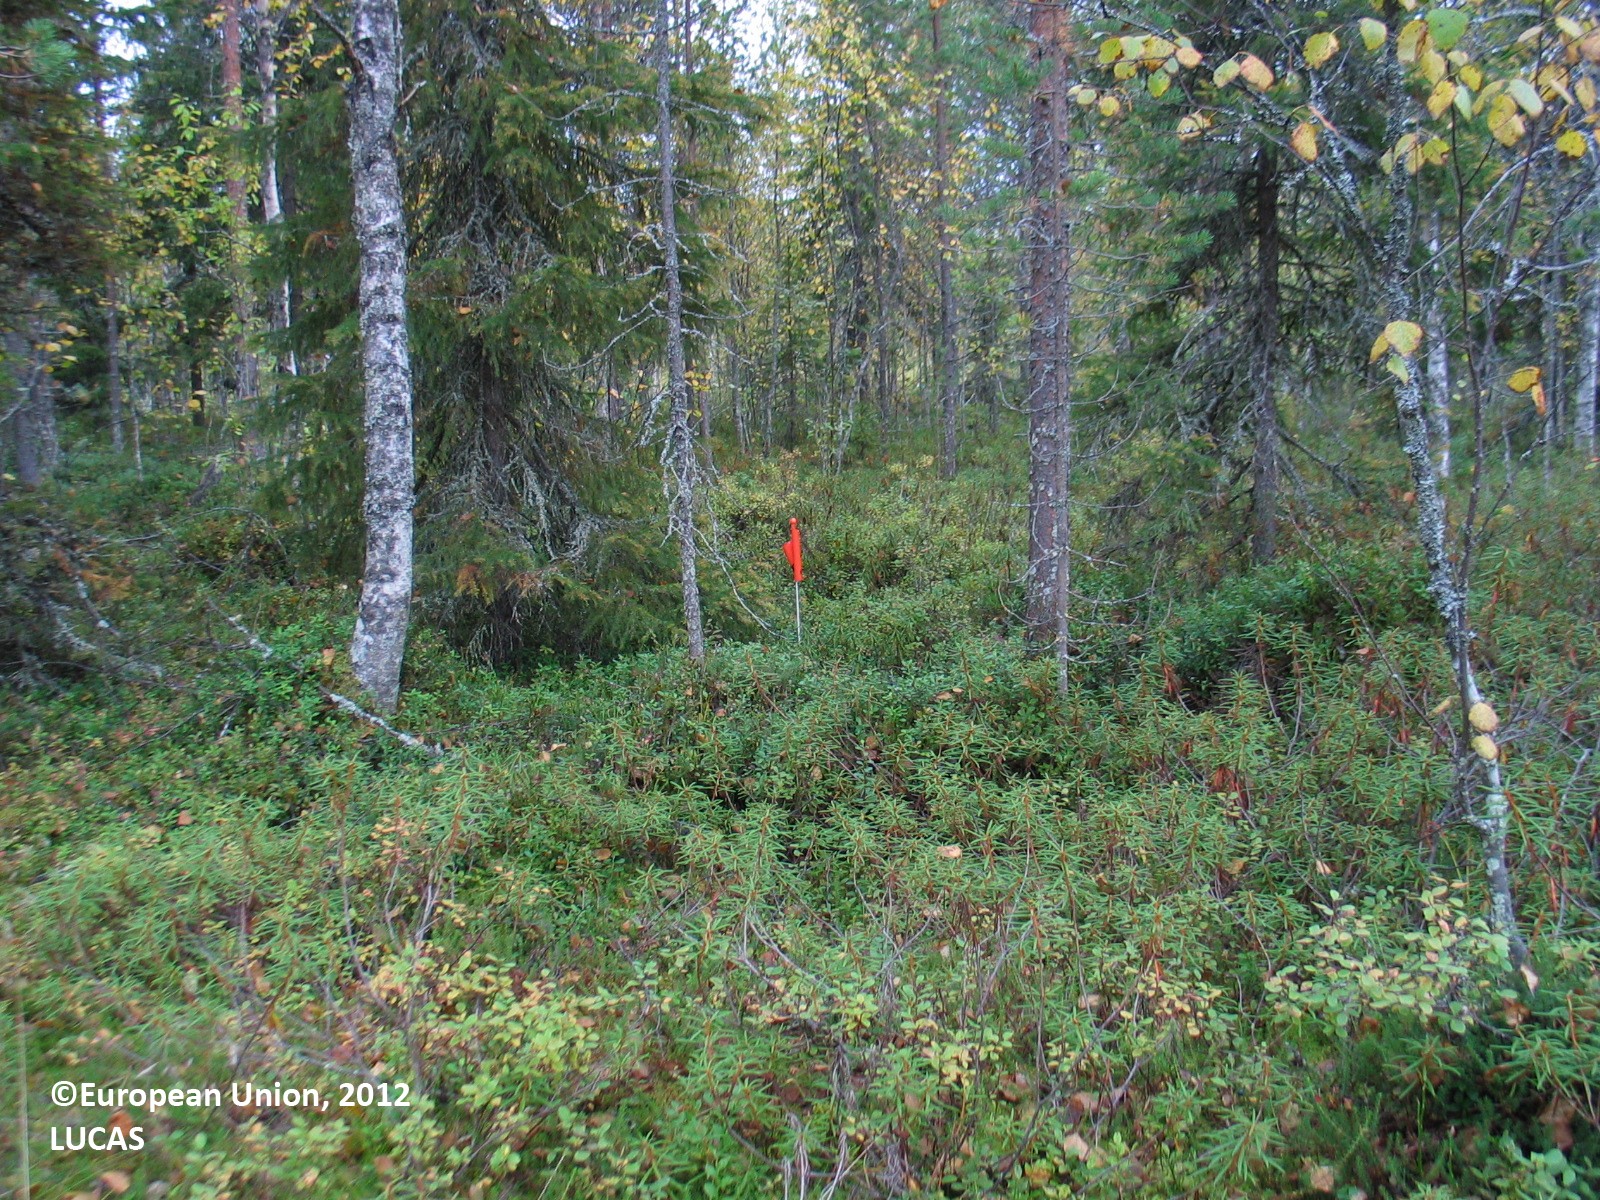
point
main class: Woodland
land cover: Other mixed woodland
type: boreal forest
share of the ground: 50 - 75 %
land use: Forestry
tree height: > 5 m
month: September
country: FI
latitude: 65.4795
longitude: 25.6948
